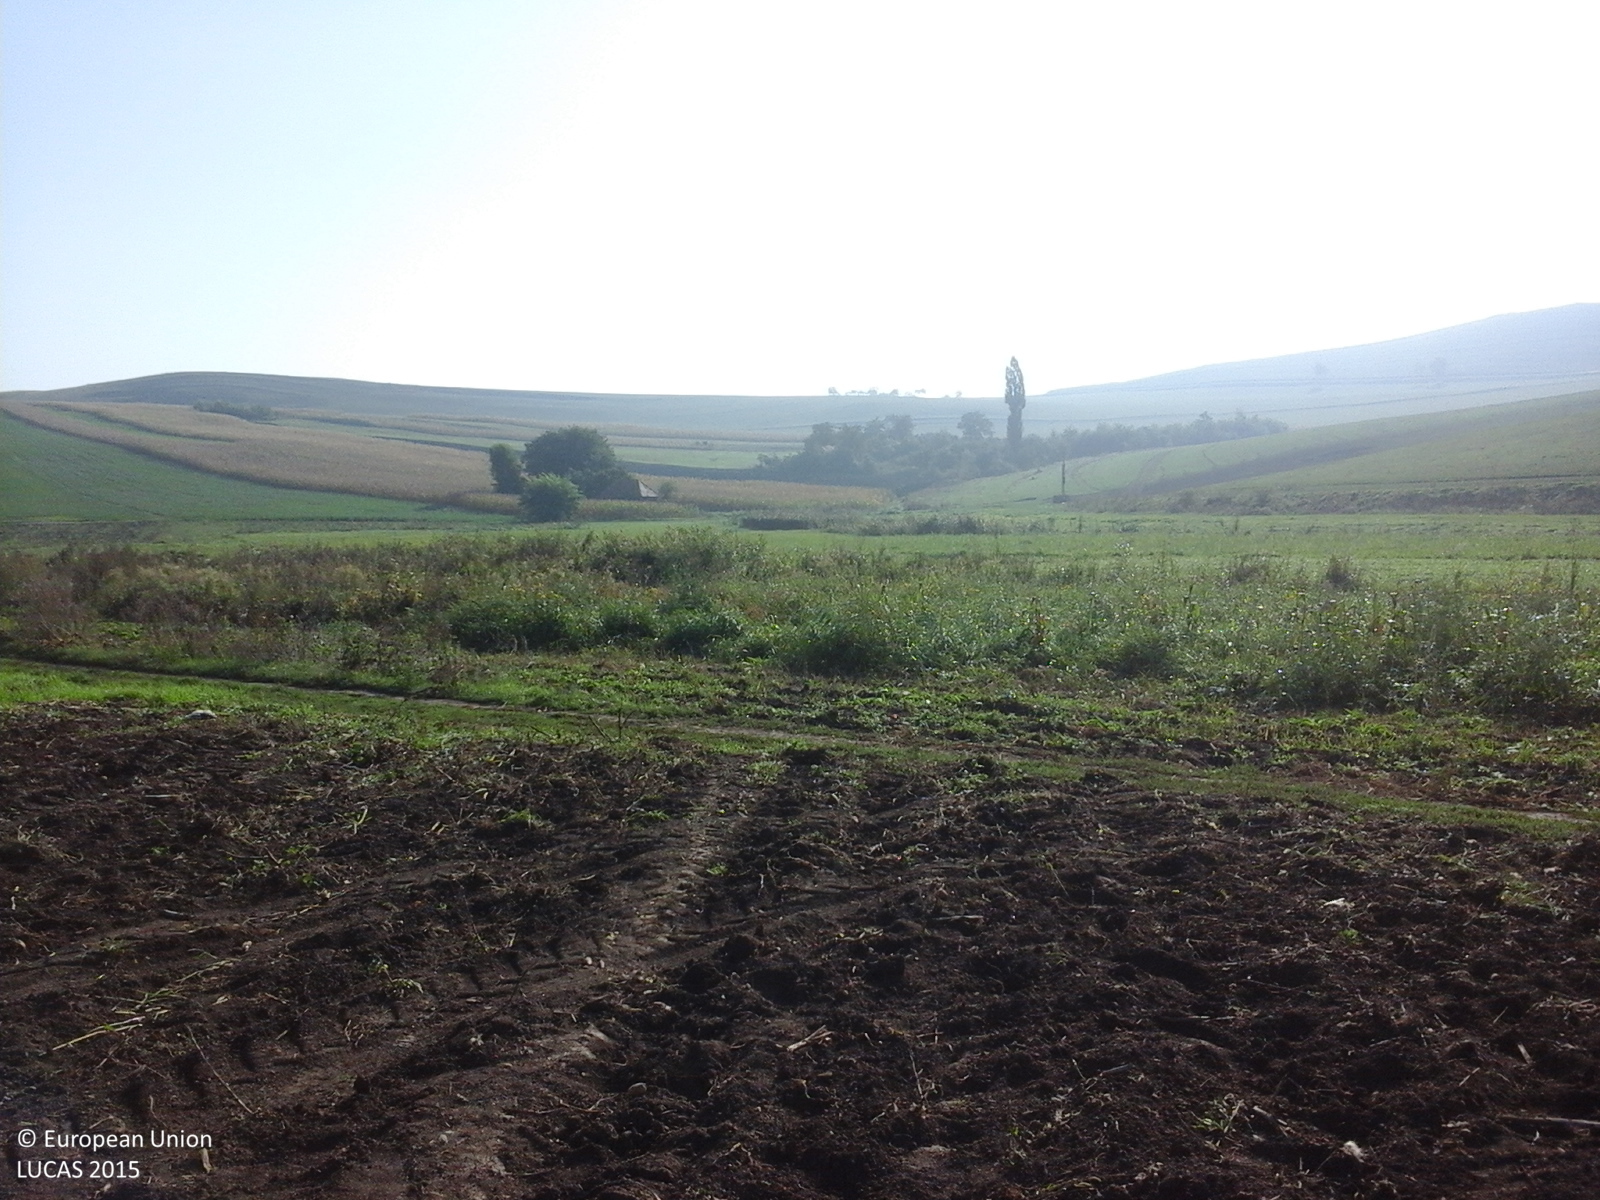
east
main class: Cropland
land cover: Potatoes
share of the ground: < 10 %
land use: Agriculture (excluding fallow land and kitchen gardens)
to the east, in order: Potatoes; Tracks; Potatoes; Spontaneously vegetated surfaces; Ditches and canals; Spontaneously vegetated surfaces; Grassland without tree/shrub cover; Tracks; Grassland without tree/shrub cover
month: September
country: RO
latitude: 46.6111
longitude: 24.0095
